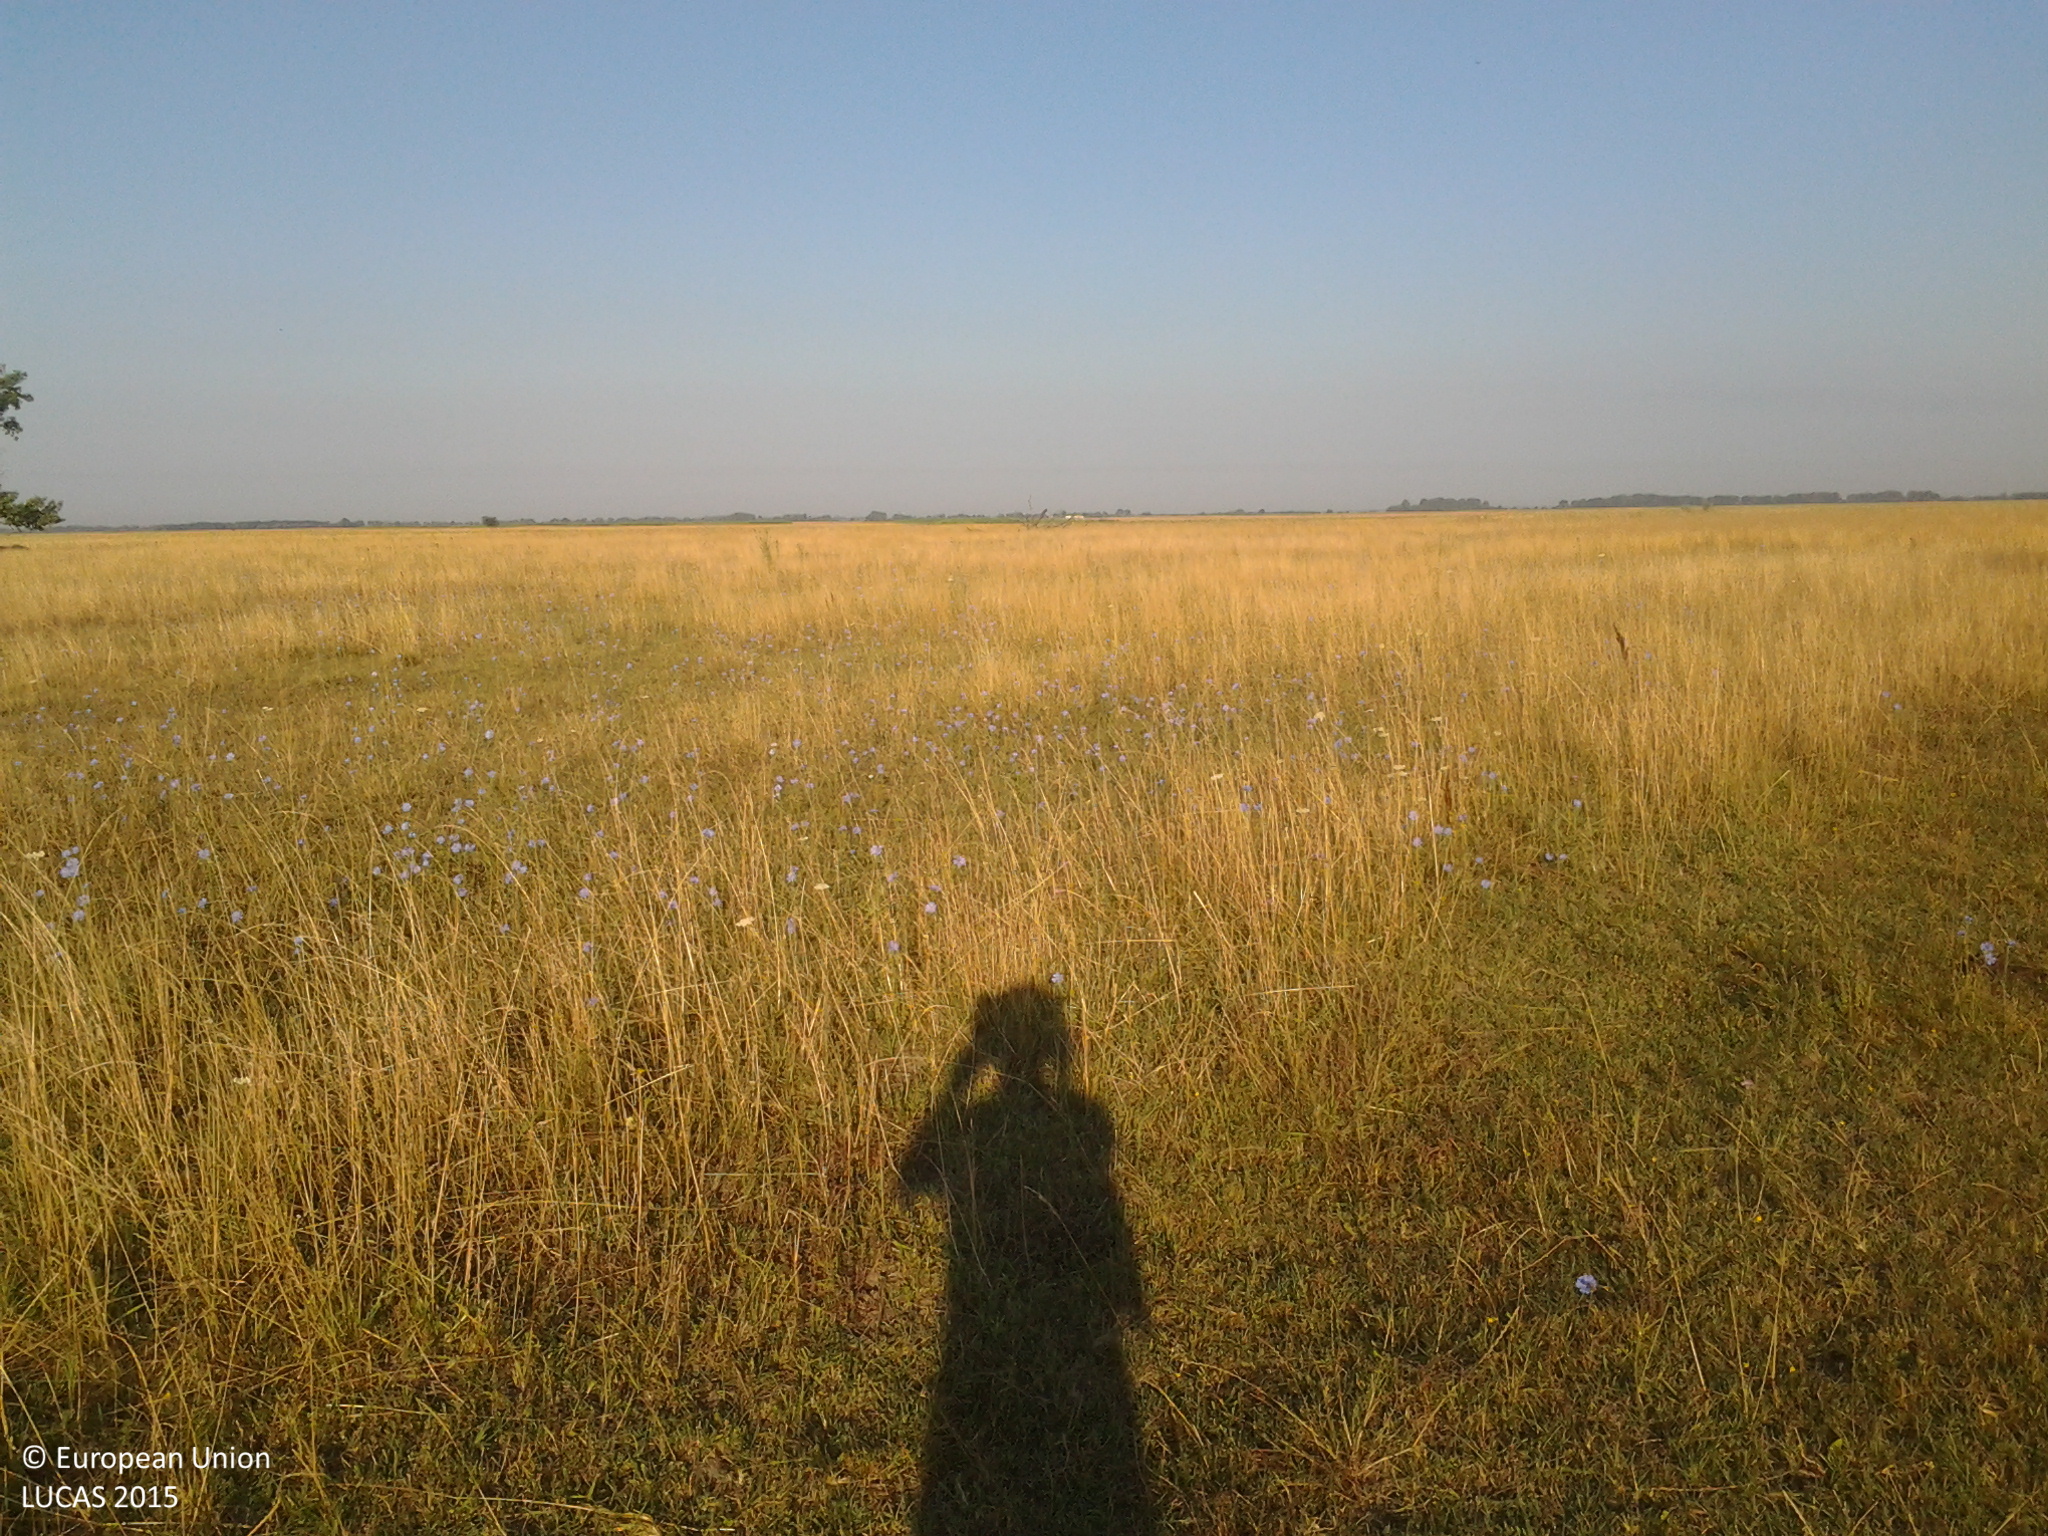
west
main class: Grassland
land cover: Grassland without tree/shrub cover
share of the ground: > 75 %
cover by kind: herbaceous plants 100 %
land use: Agriculture (excluding fallow land and kitchen gardens)
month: July
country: HU
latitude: 46.7676
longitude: 19.2218
